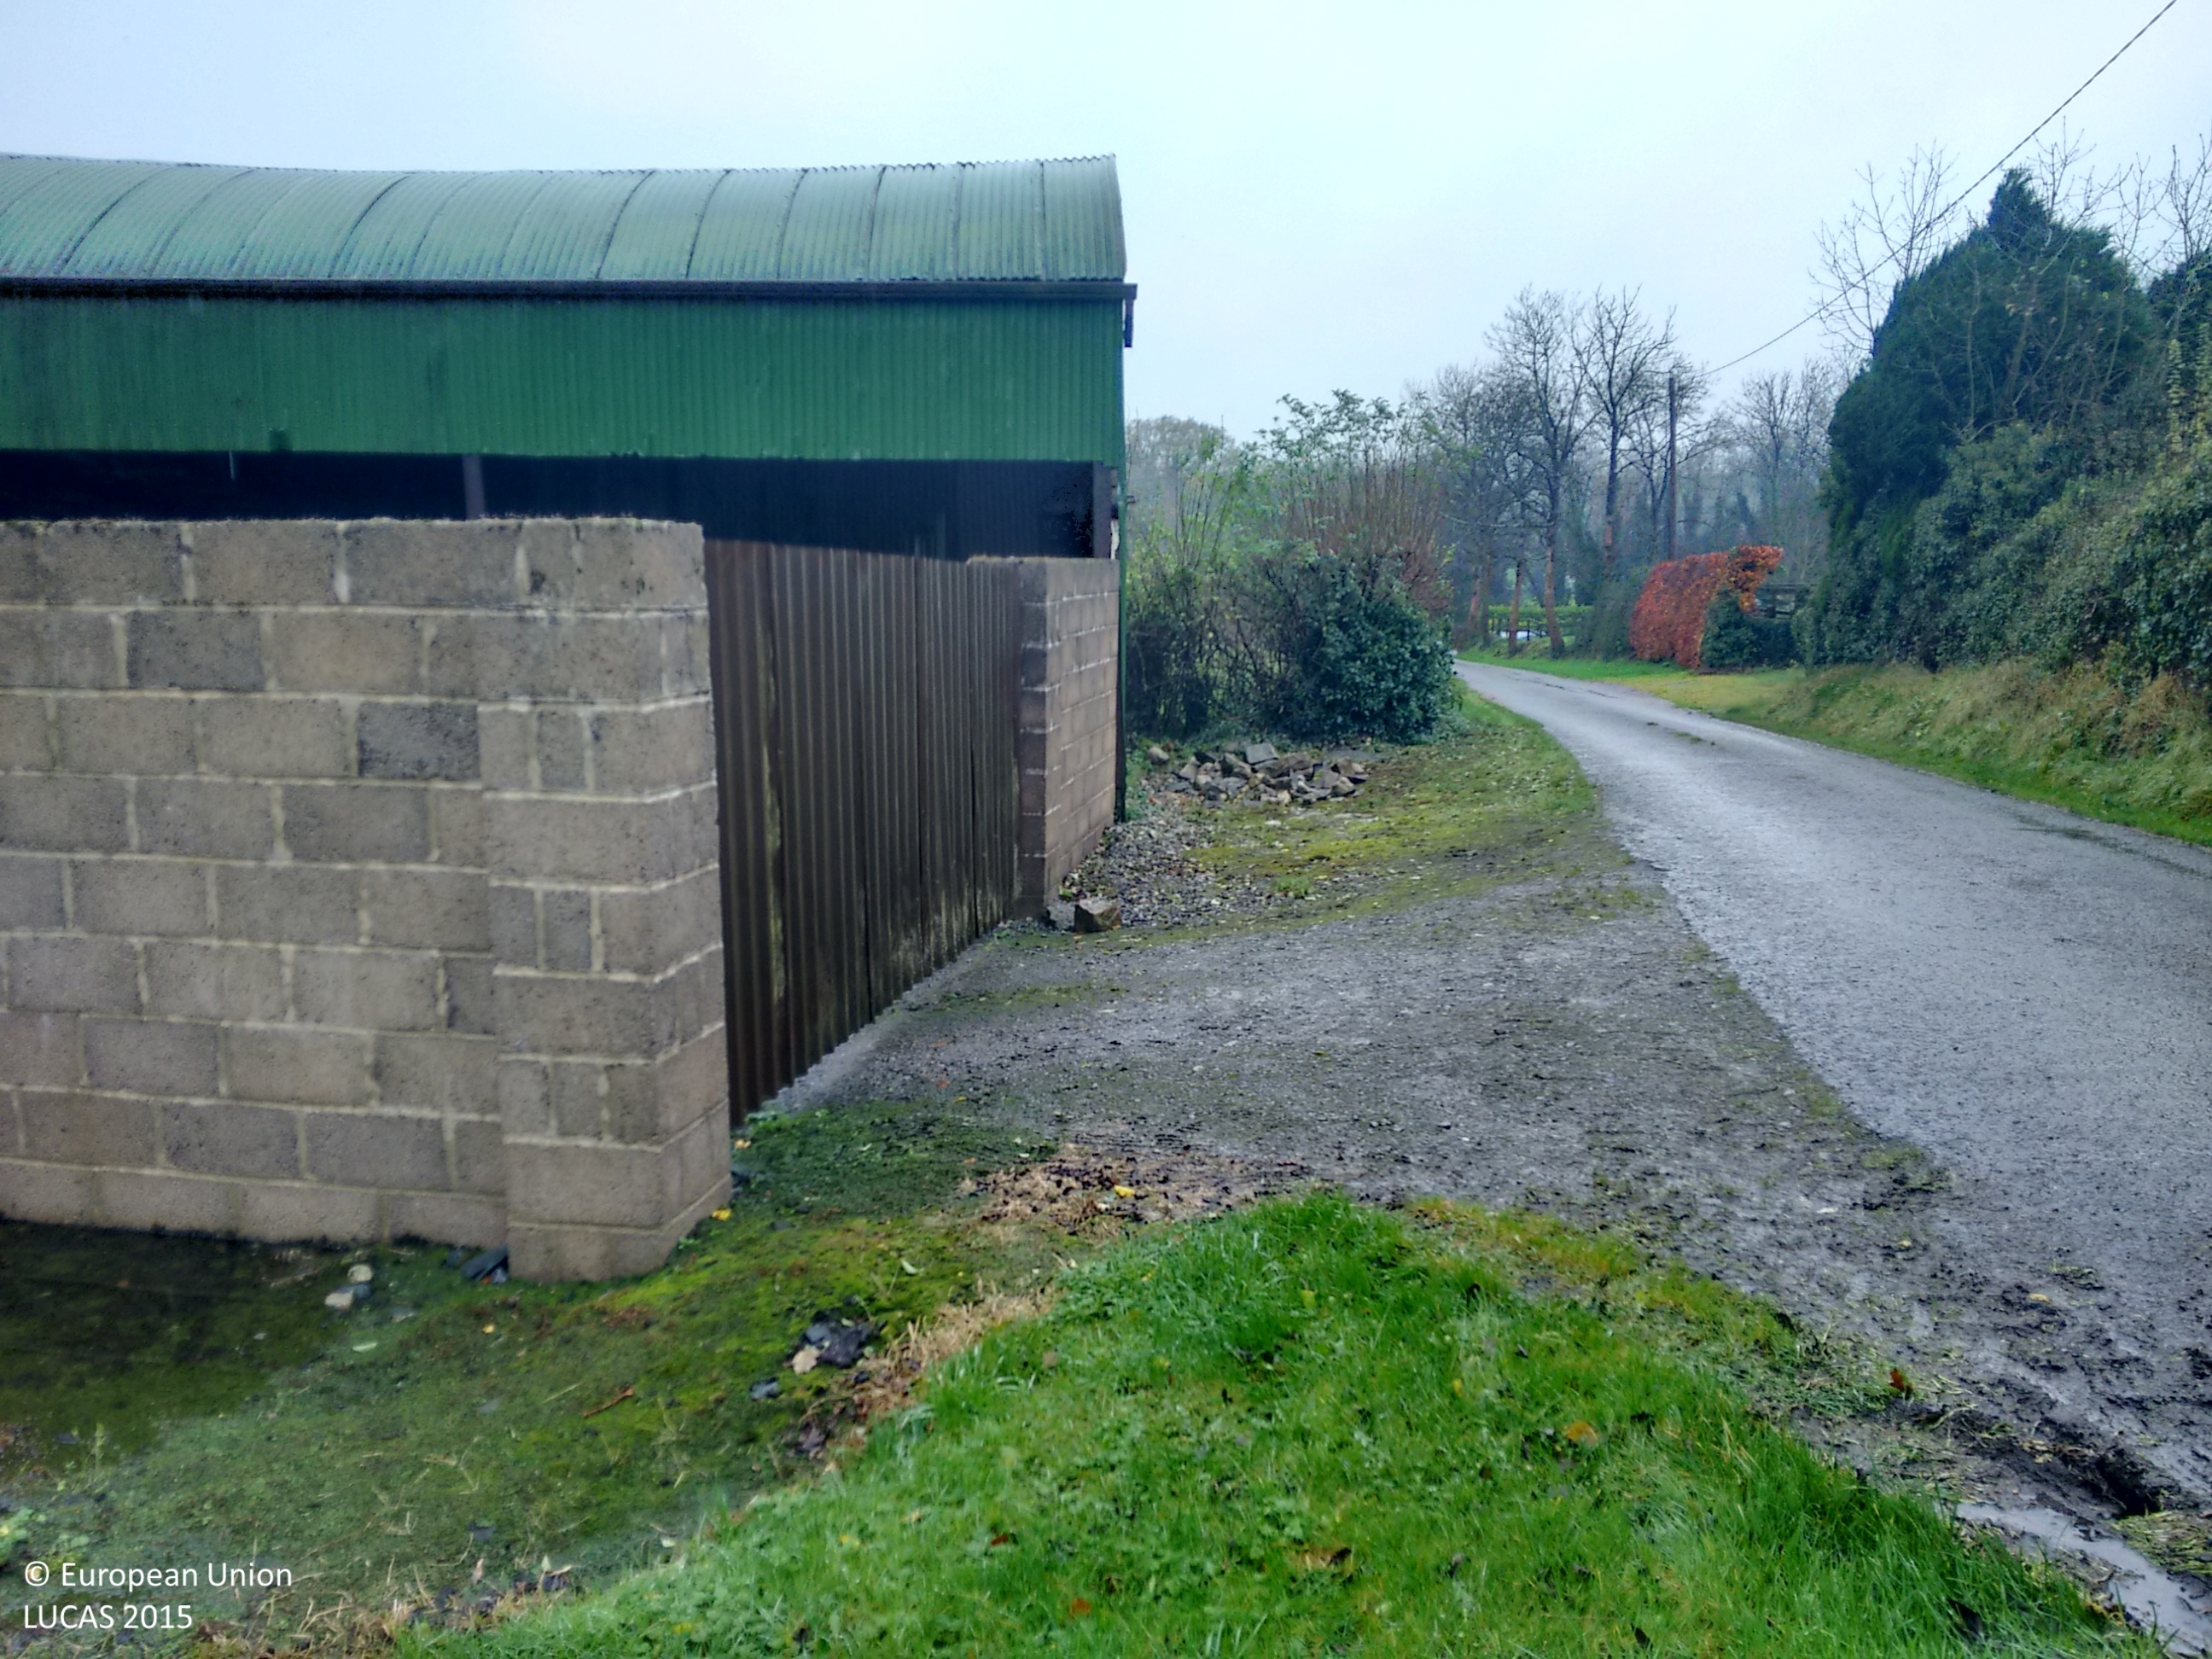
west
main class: Grassland
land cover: Grassland without tree/shrub cover
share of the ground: > 75 %
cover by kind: herbaceous plants 100 %
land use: Agriculture (excluding fallow land and kitchen gardens)
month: November
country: IE
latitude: 53.9232
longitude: -7.8483
